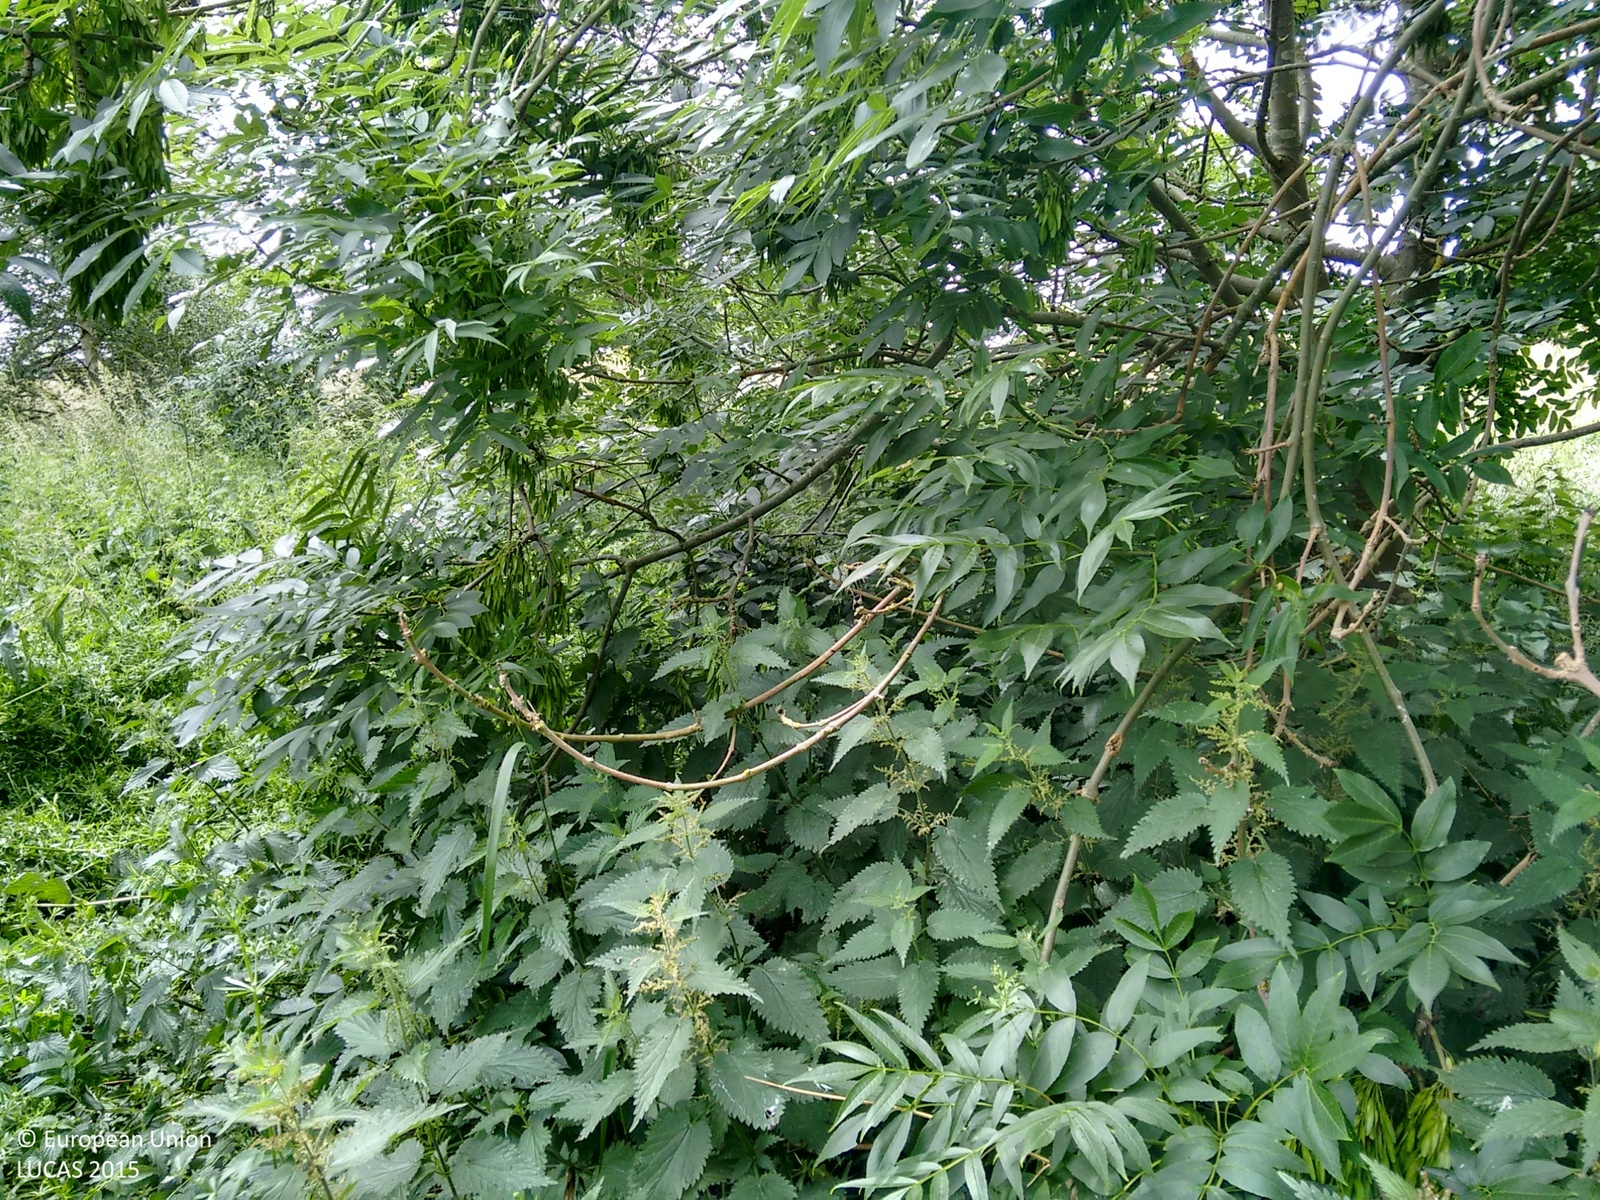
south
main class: Grassland
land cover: Grassland with sparse tree/shrub cover
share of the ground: > 75 %
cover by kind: herbaceous plants 95 %, broadleaved forest trees 5 %
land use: Semi-natural and natural areas not in use
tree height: < 5 m
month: June
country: GB
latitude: 52.5912
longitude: 0.0335
